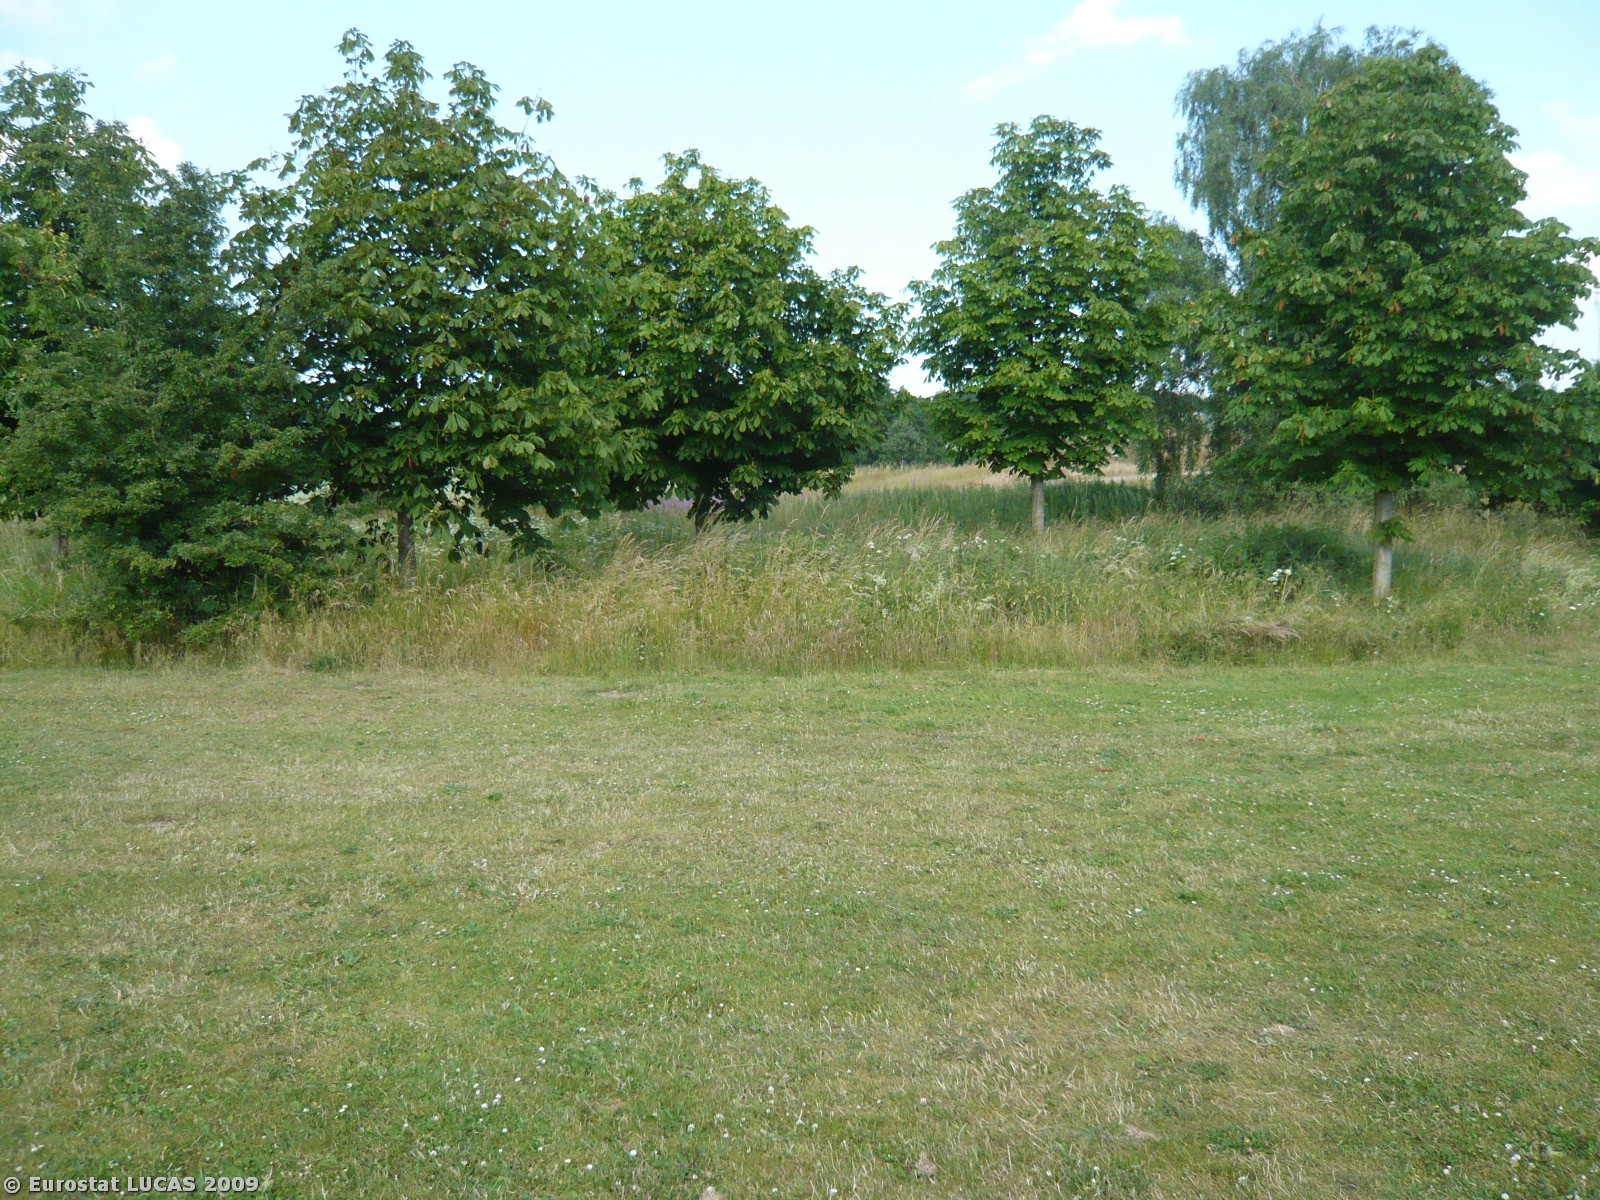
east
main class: Grassland
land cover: Grassland without tree/shrub cover
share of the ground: > 75 %
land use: Sport
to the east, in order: Grassland without tree/shrub cover; Grassland with sparse tree/shrub cover; Spontaneously vegetated surfaces; Tracks; Artificial constructions; Spontaneously vegetated surfaces; Barley; Grass margins; Paved roads, cycling and walking lanes; Grassland without tree/shrub cover; Common wheat; Tracks; Electric lines; Common wheat
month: July
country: DK
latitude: 55.3786
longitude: 10.2681
